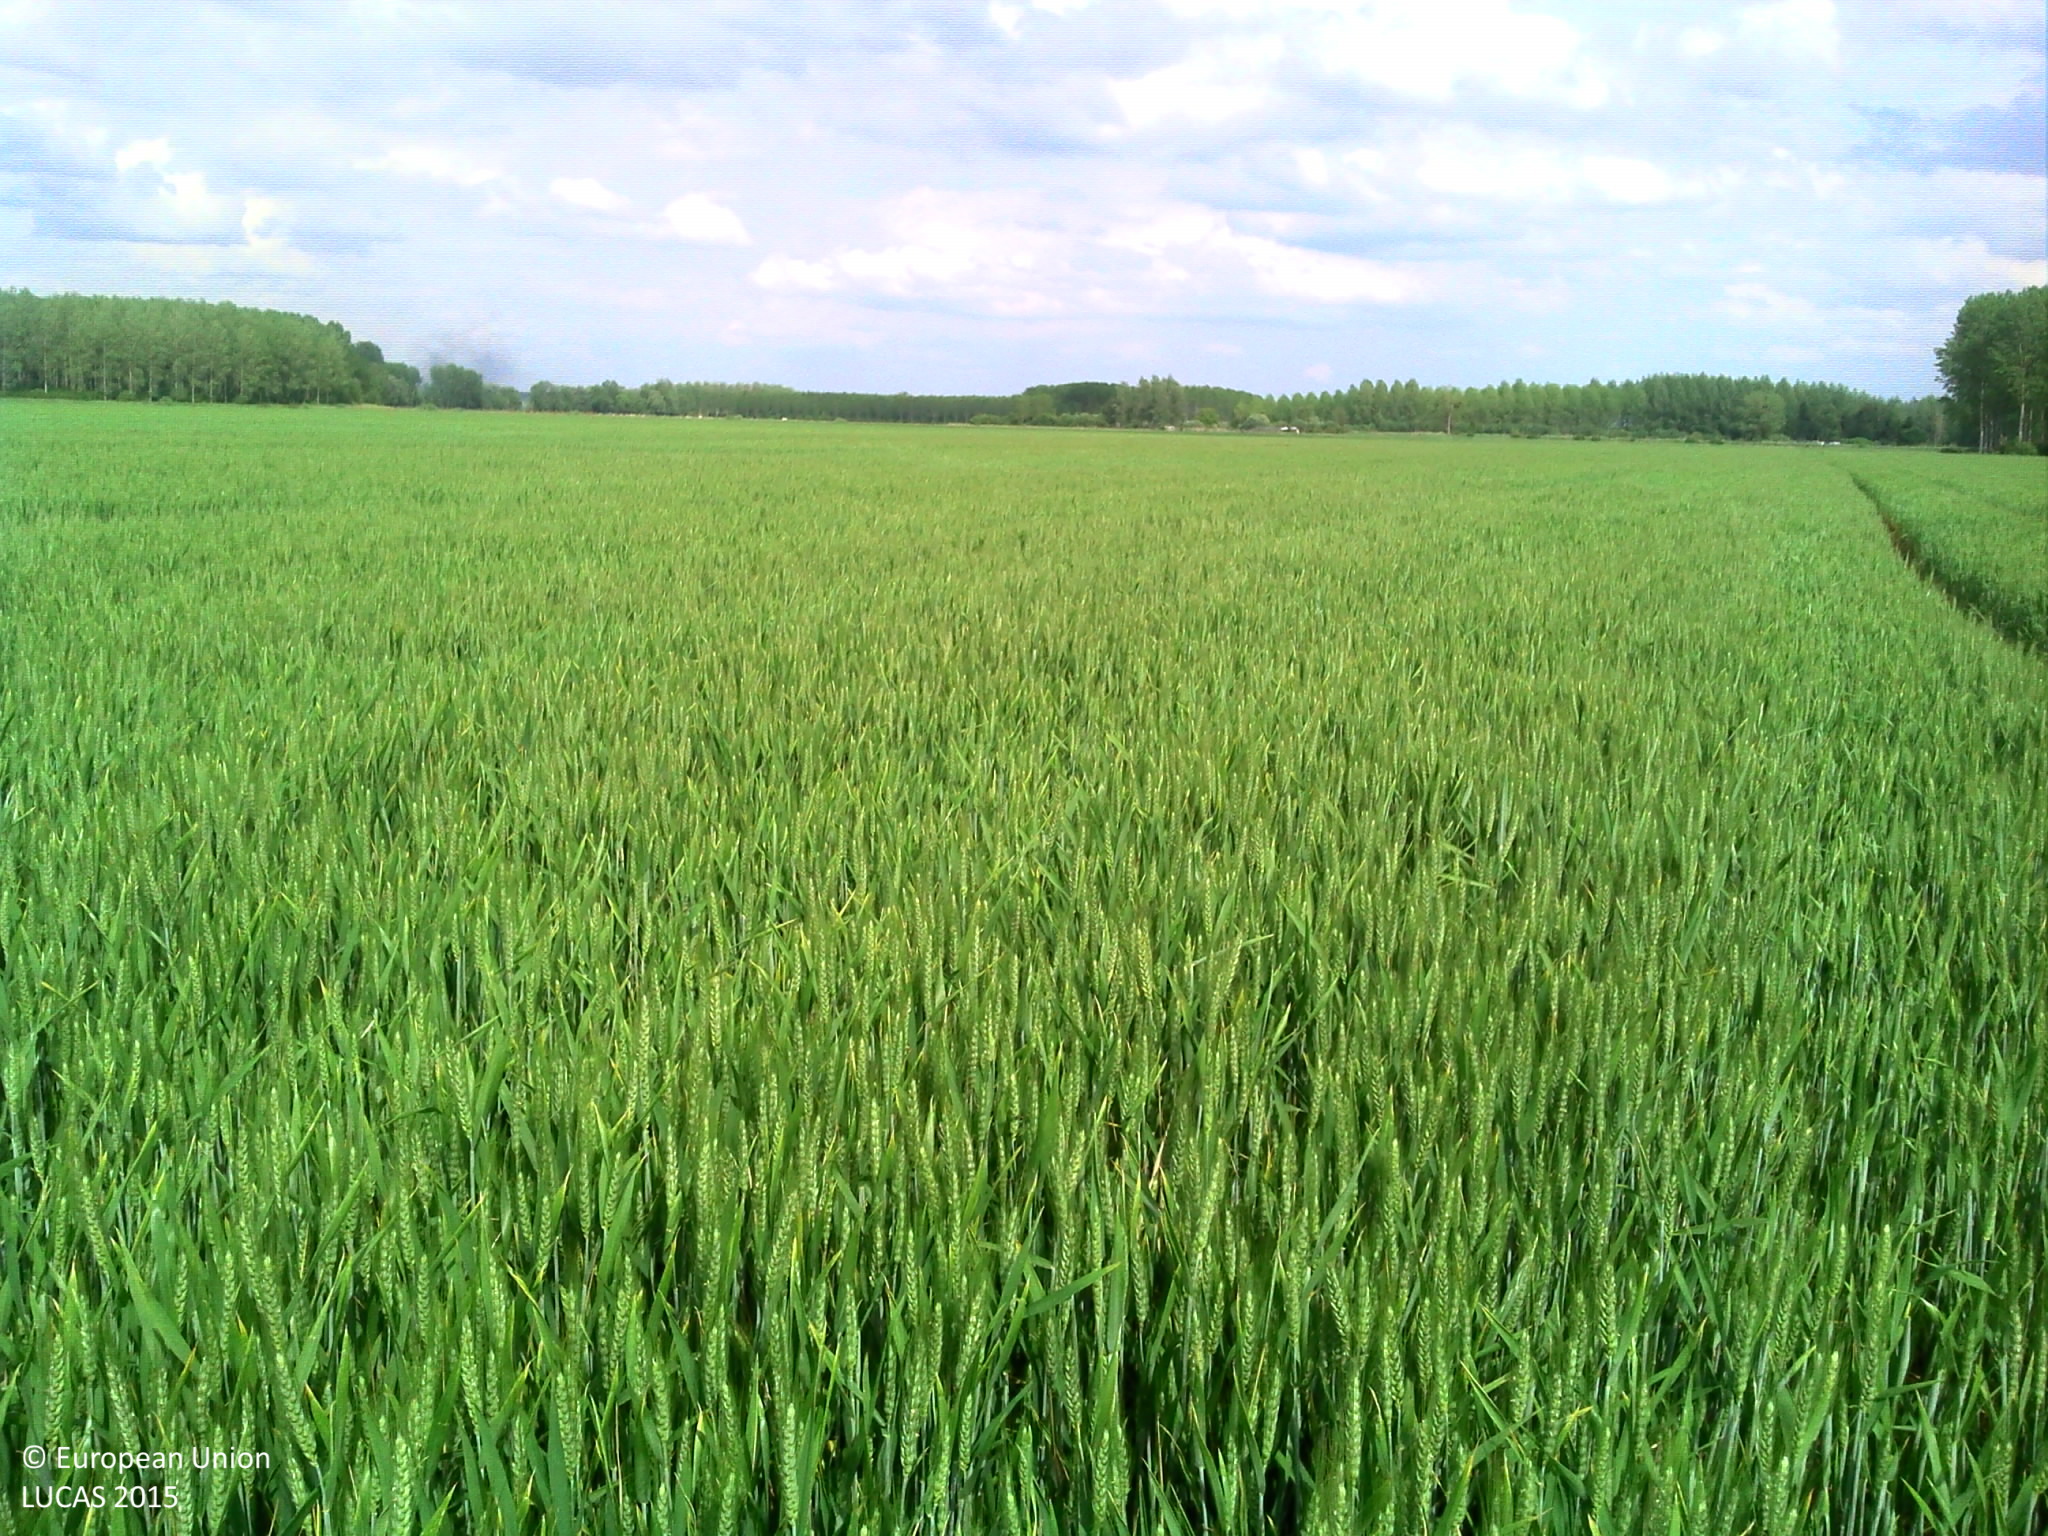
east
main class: Cropland
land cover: Common wheat
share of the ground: > 75 %
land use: Agriculture (excluding fallow land and kitchen gardens)
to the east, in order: Common wheat
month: May
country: FR
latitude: 48.5892
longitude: 4.8325
